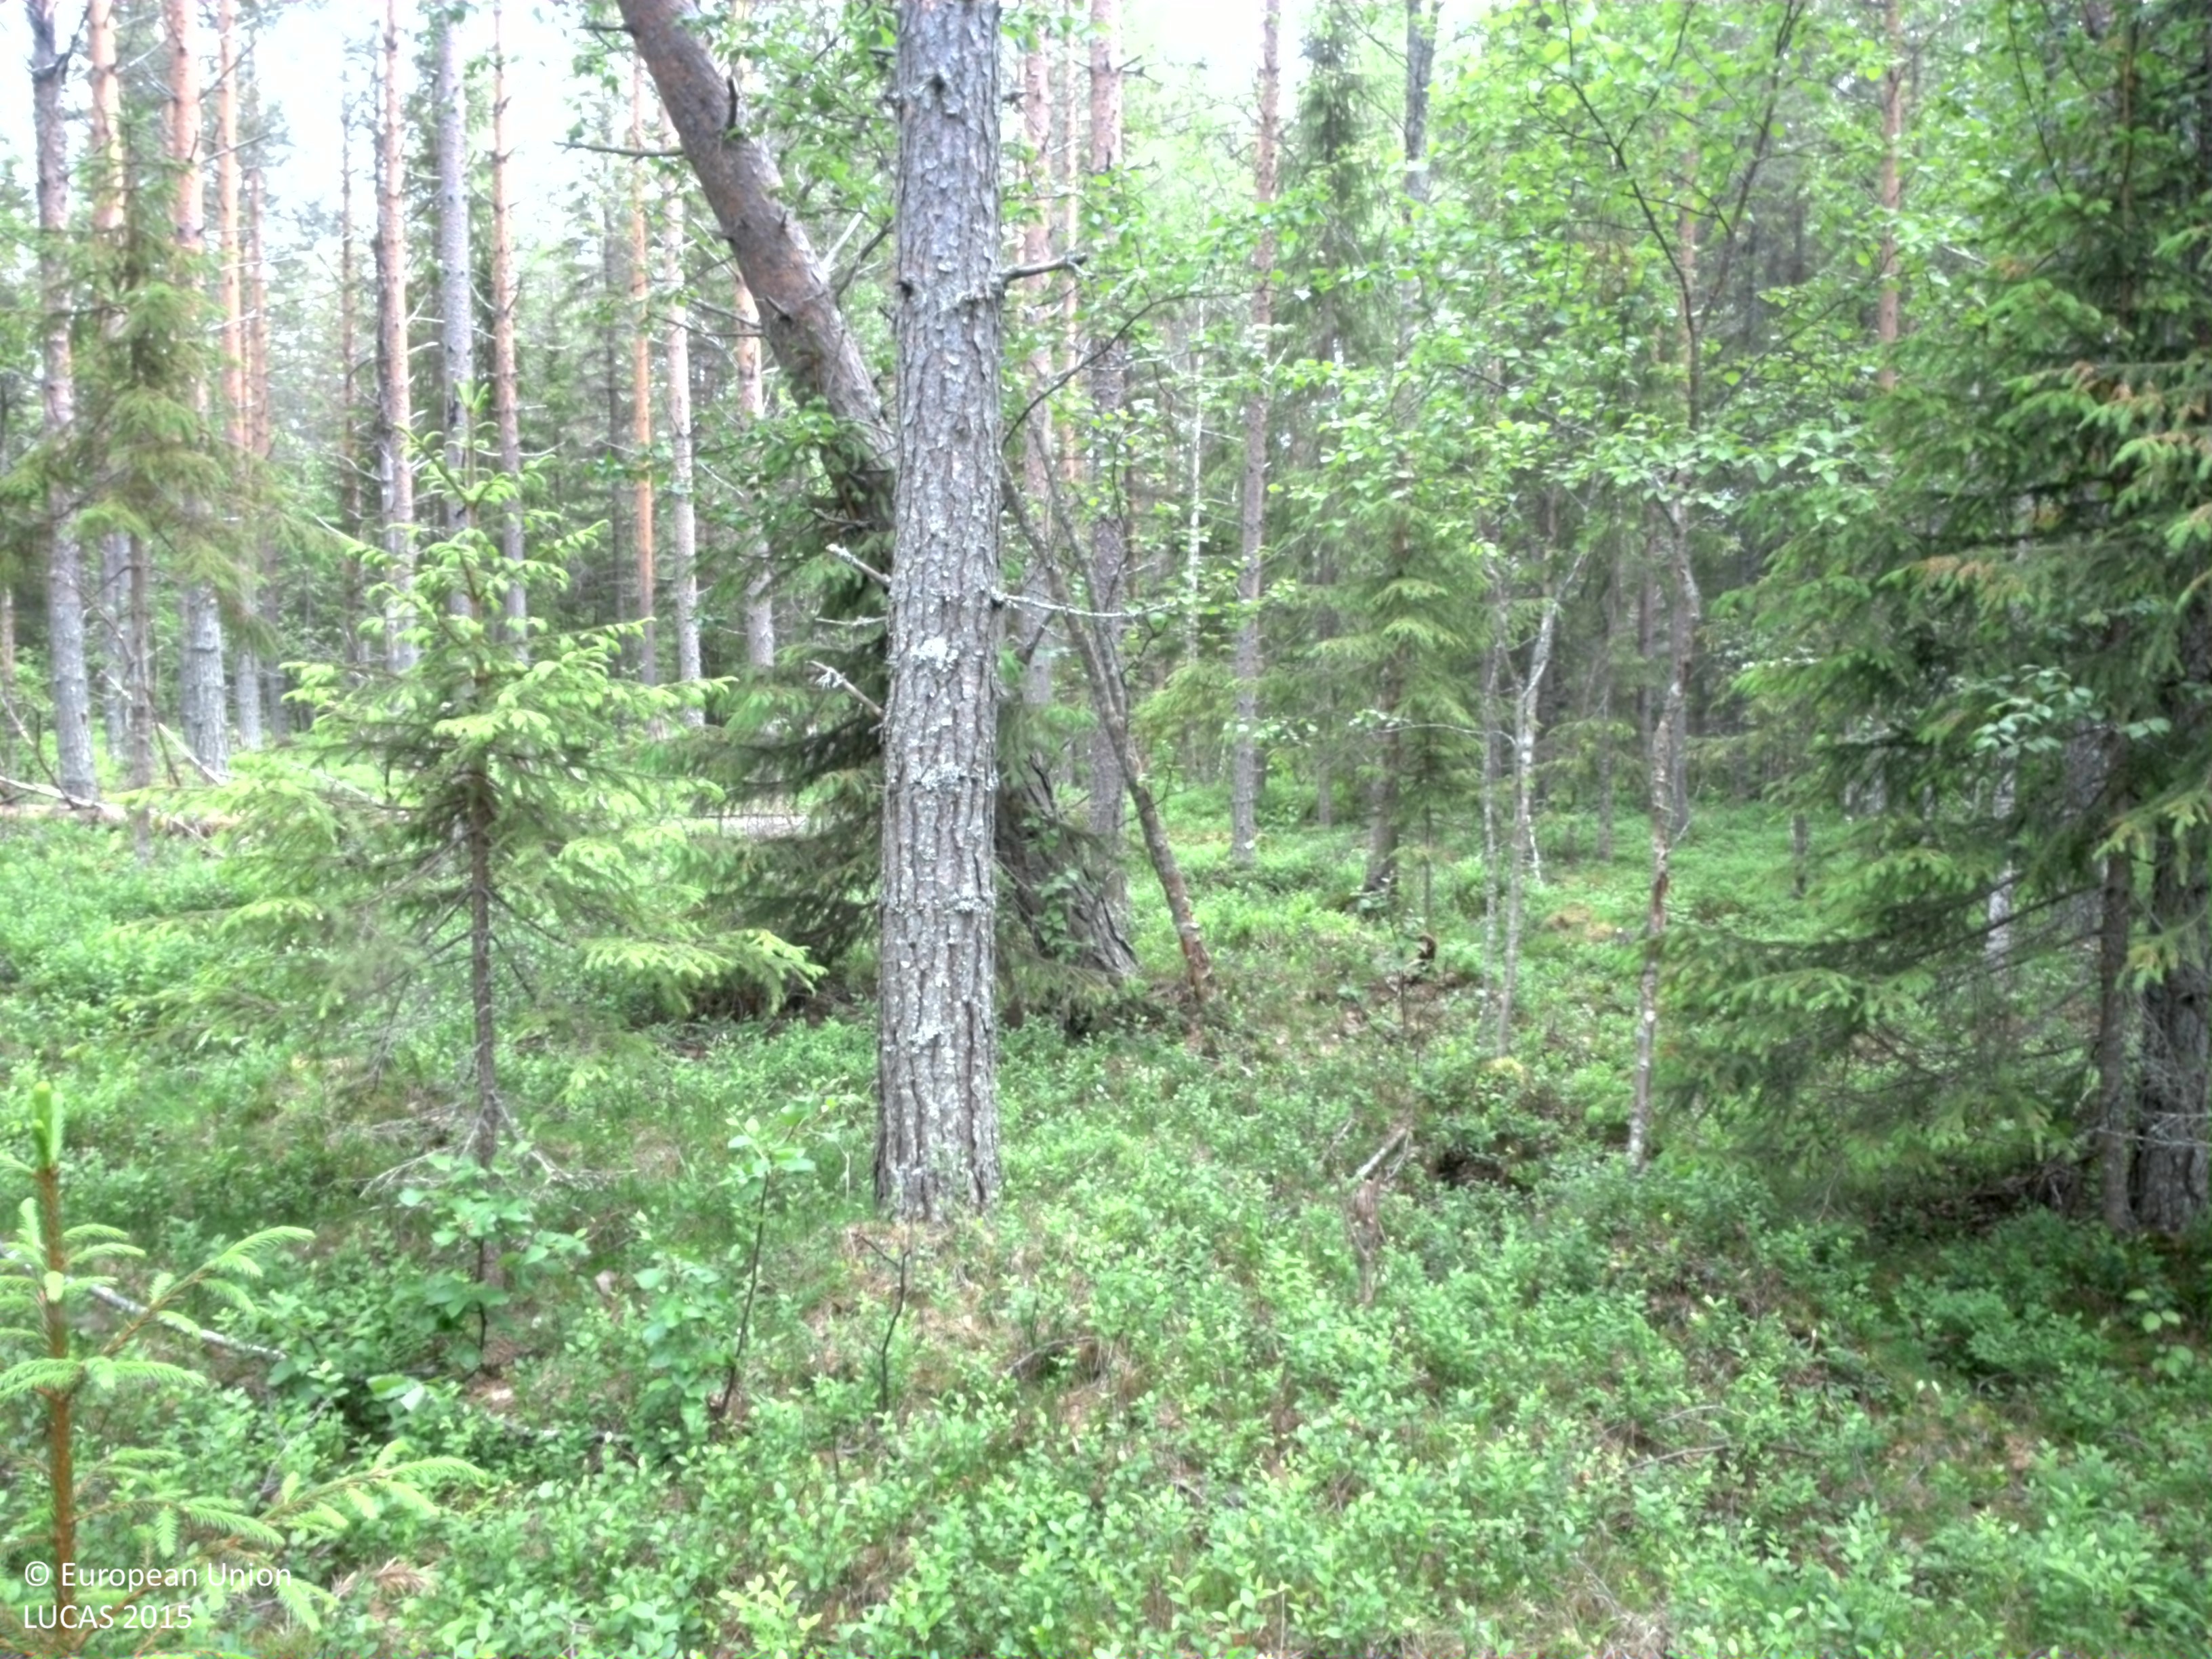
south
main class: Woodland
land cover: Pine dominated mixed woodland
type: boreal forest
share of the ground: 50 - 75 %
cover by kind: coniferous forest trees 45 %, shrubs 30 %, broadleaved forest trees 15 %, herbaceous plants 10 %
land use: Forestry
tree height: > 5 m
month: August
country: SE
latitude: 64.5291
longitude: 18.2414
